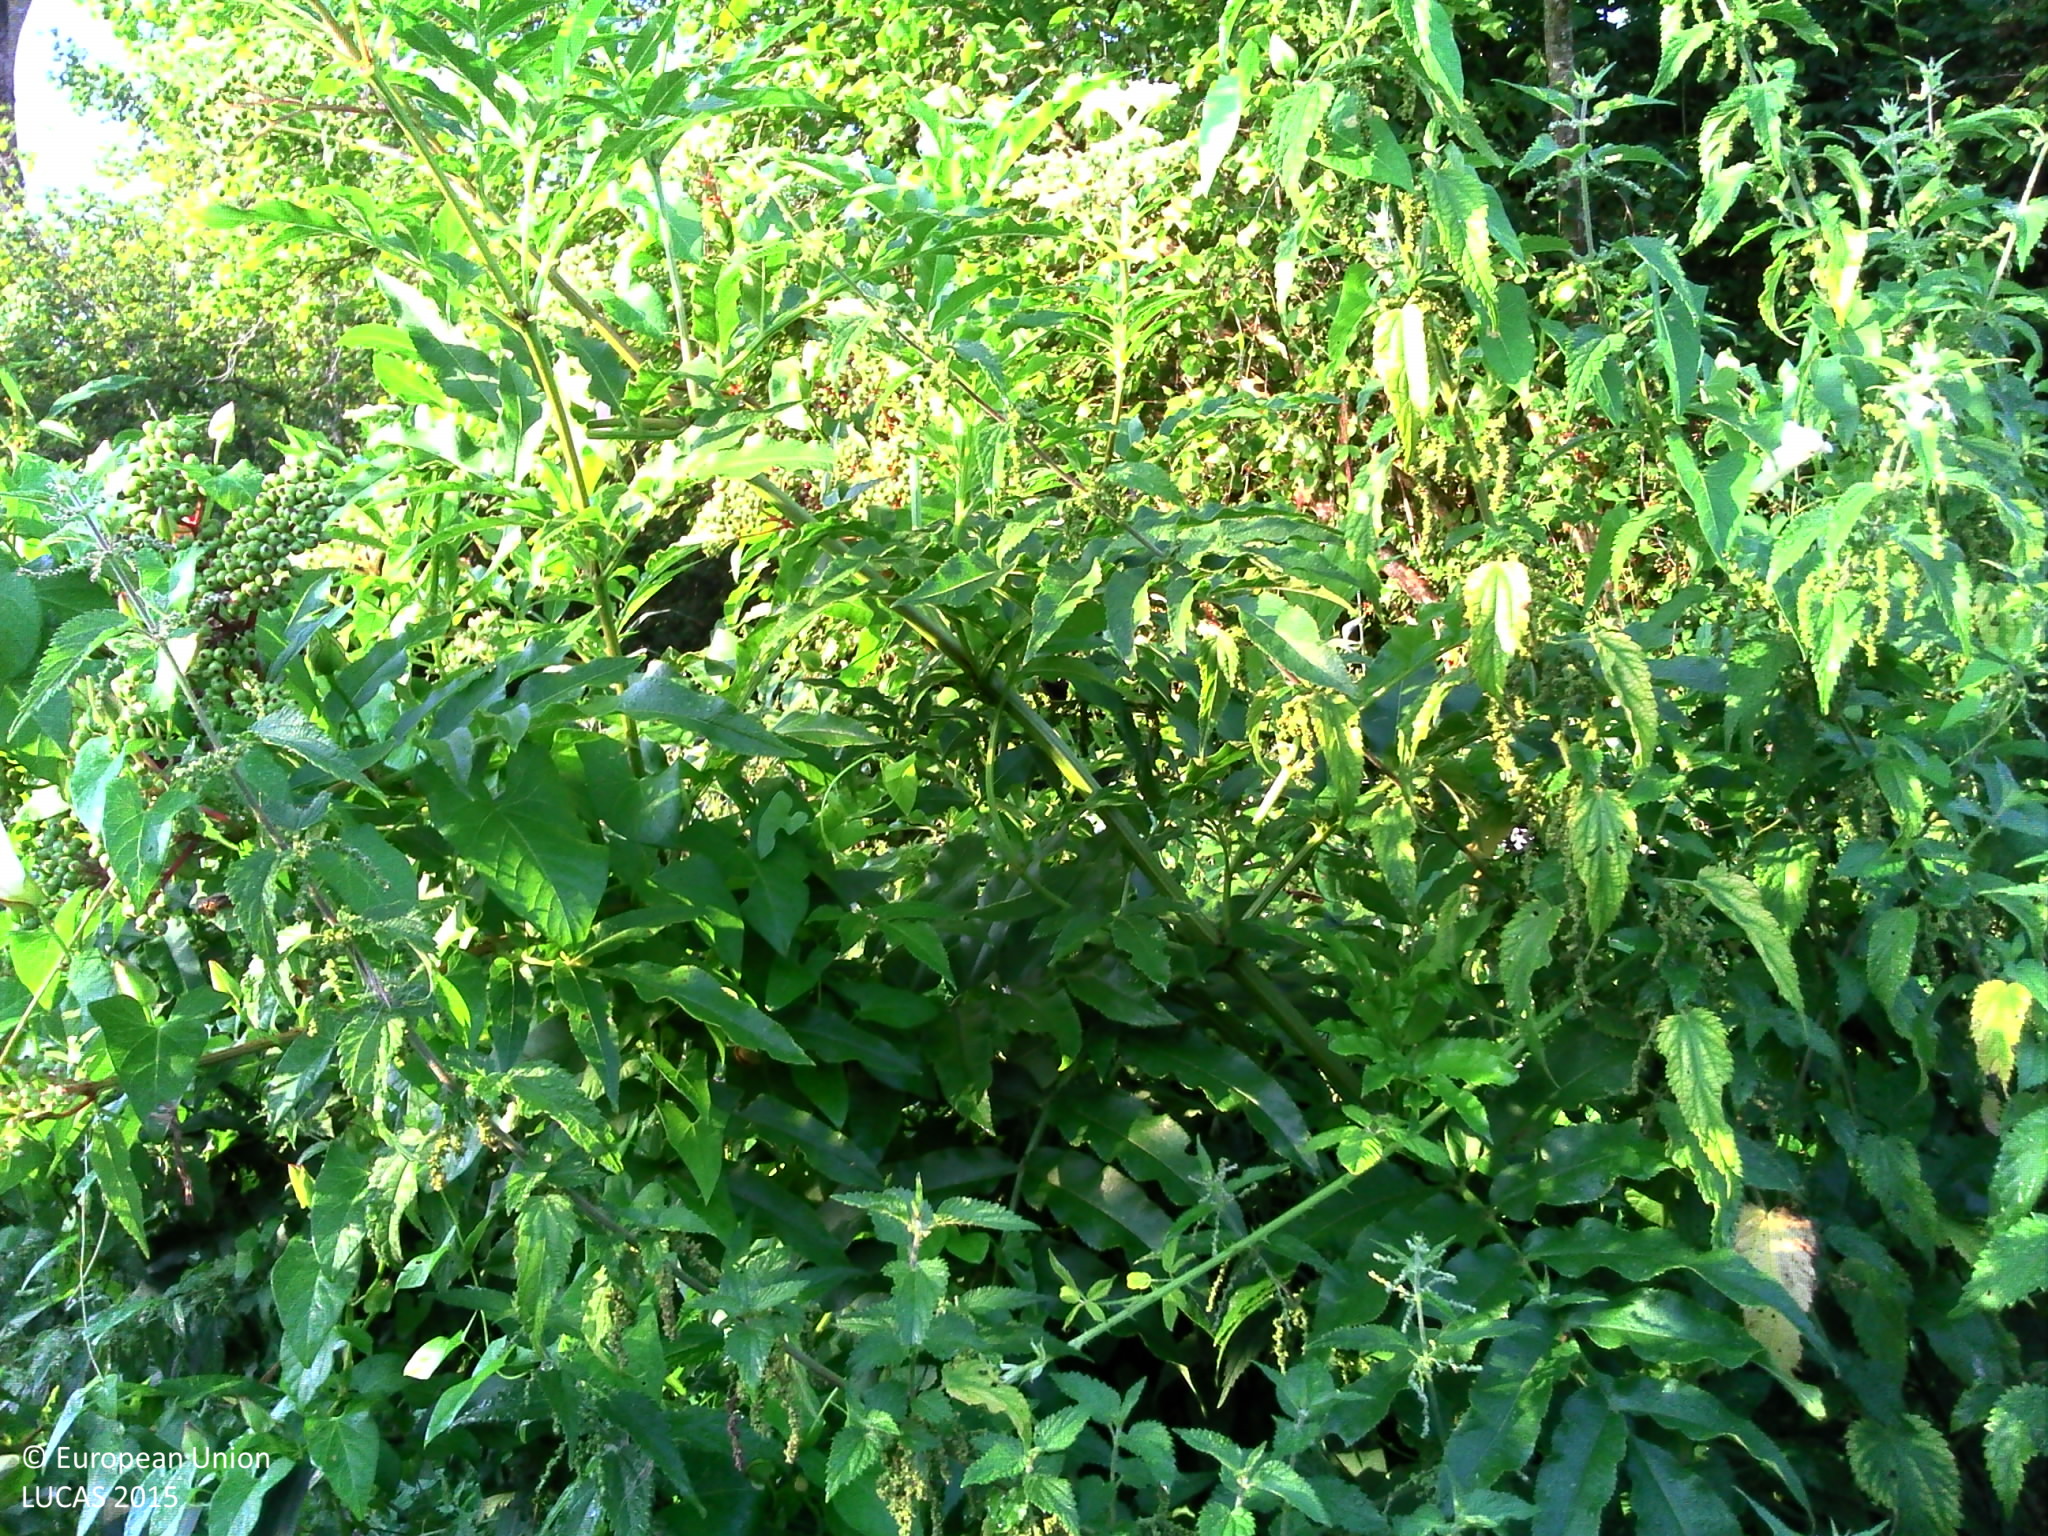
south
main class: Woodland
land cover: Broadleaved woodland
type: thermophilous deciduous forest
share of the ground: > 75 %
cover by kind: broadleaved forest trees 80 %, herbaceous plants 20 %
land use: Forestry
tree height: > 5 m
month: August
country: FR
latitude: 44.8250
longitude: 0.9505
